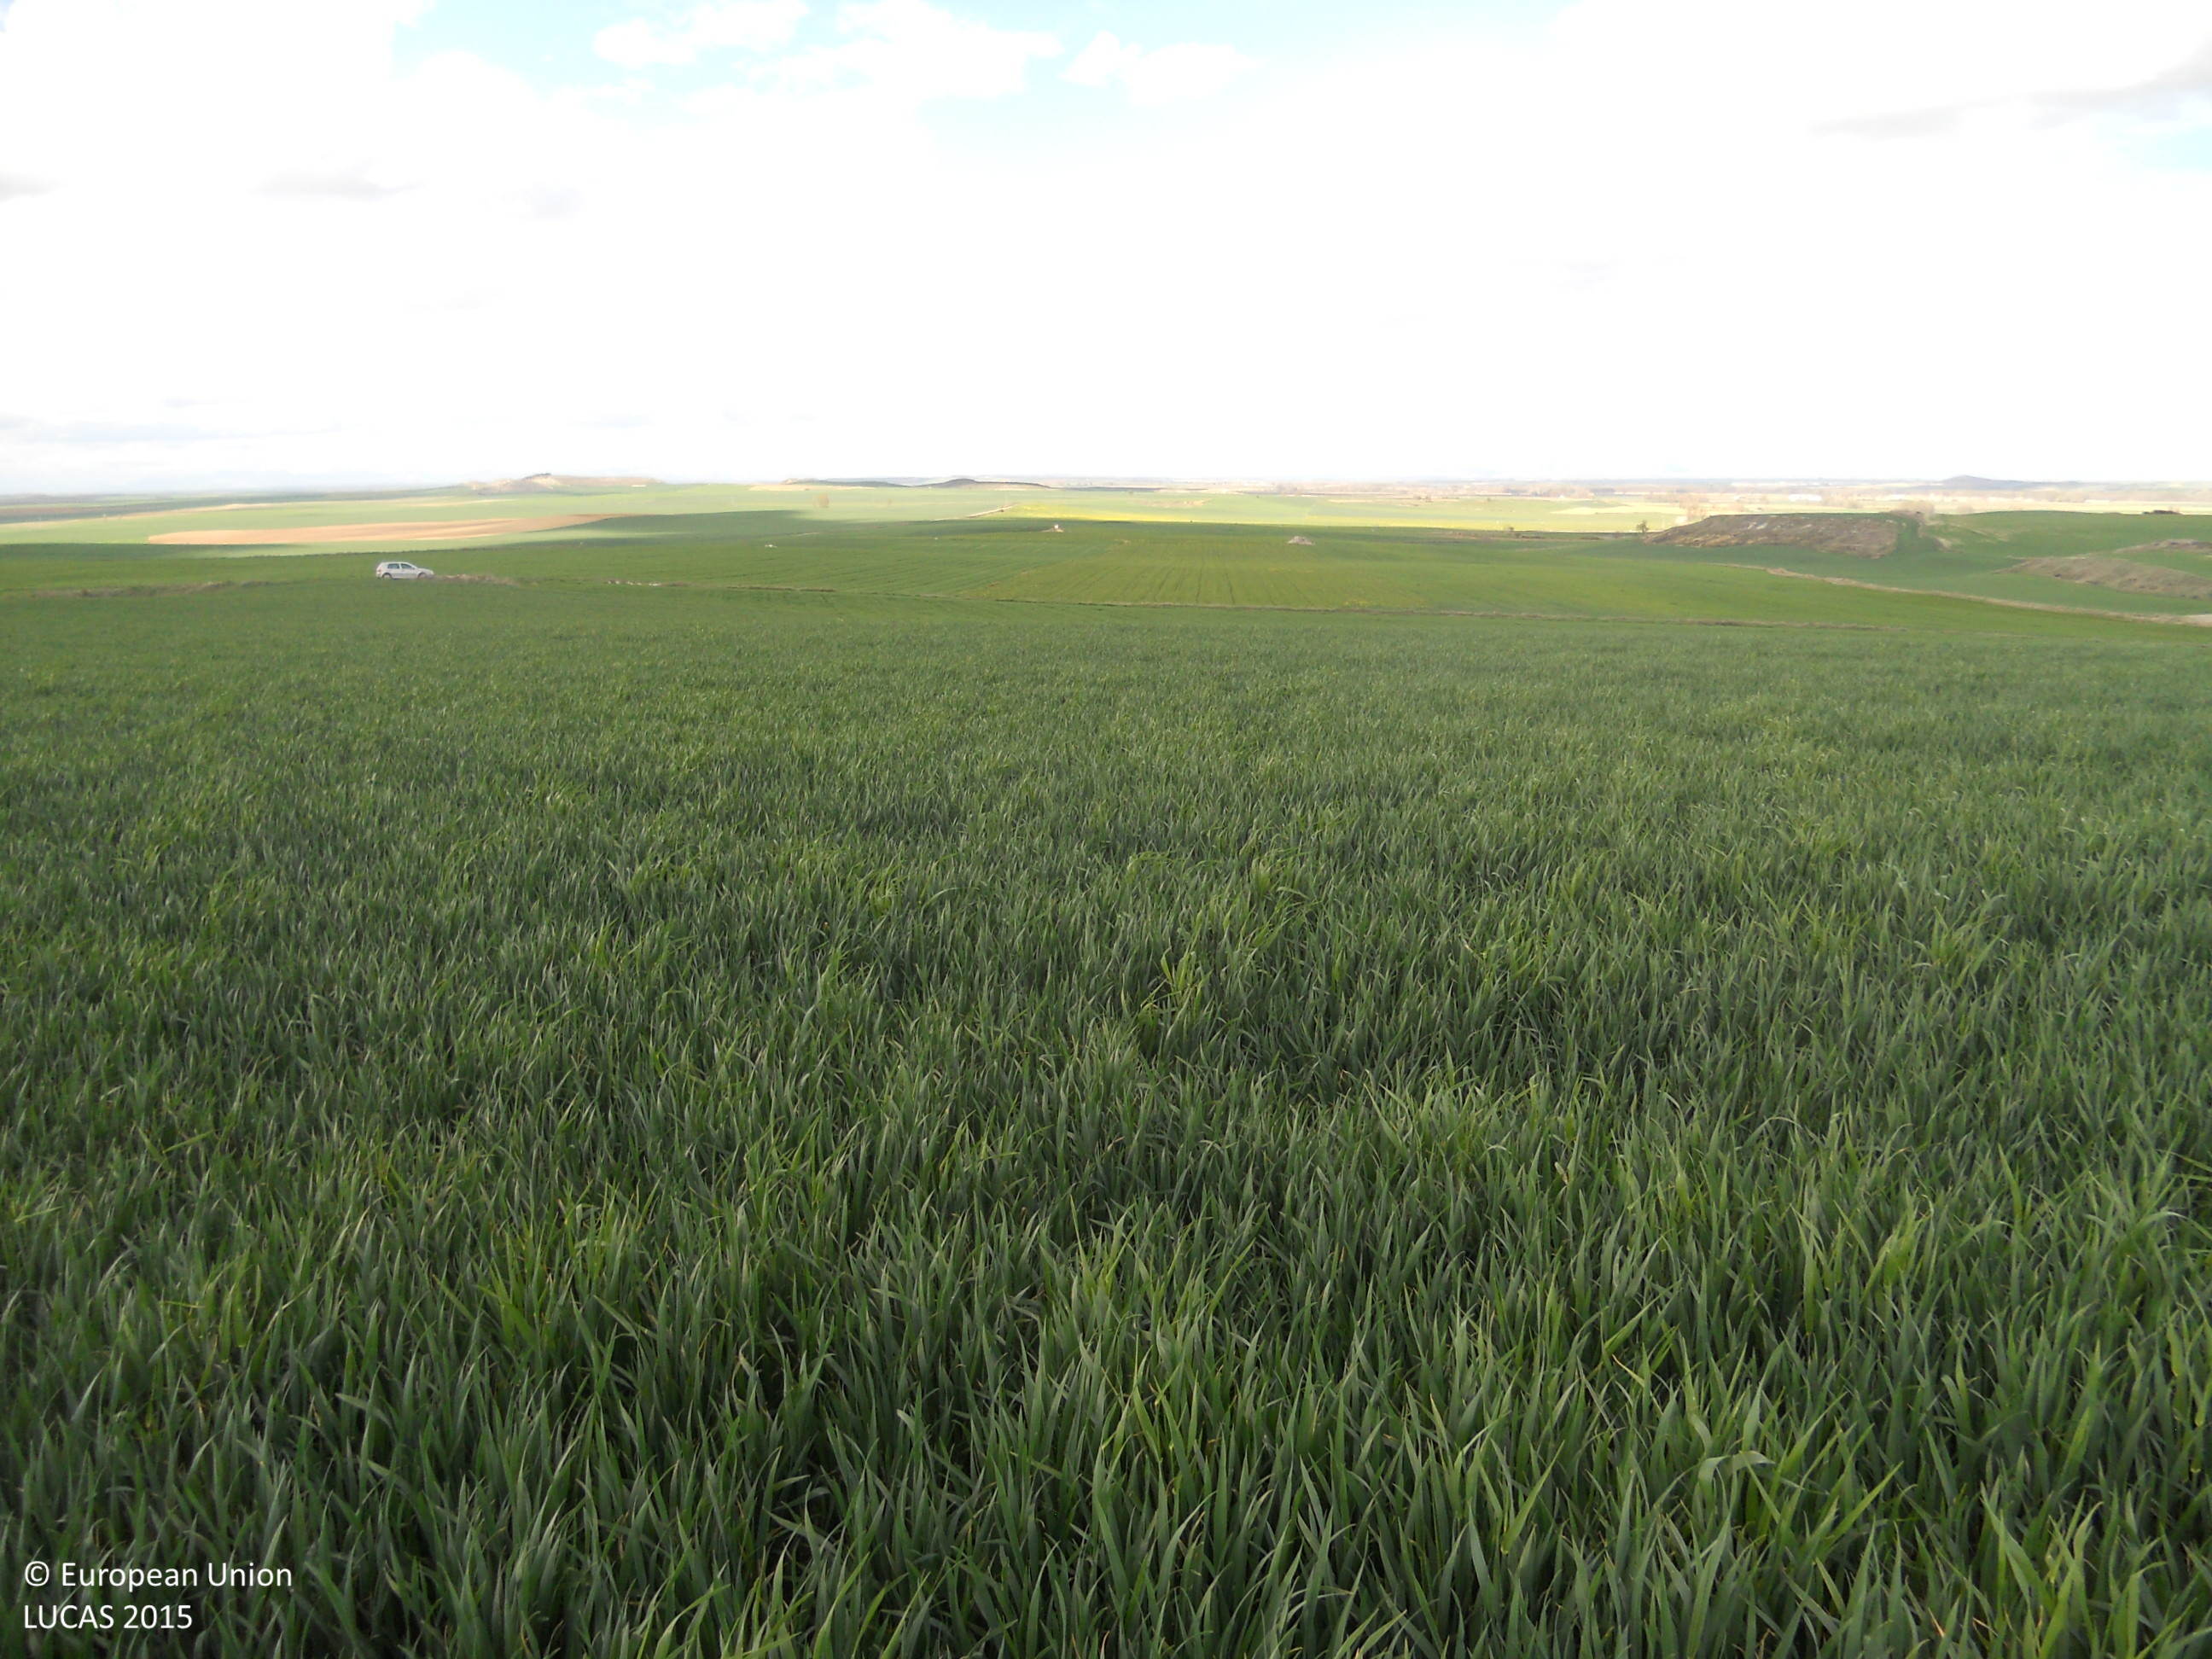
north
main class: Cropland
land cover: Barley
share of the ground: > 75 %
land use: Agriculture (excluding fallow land and kitchen gardens)
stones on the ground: < 10 %
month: April
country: ES
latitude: 42.2400
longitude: -4.2836
